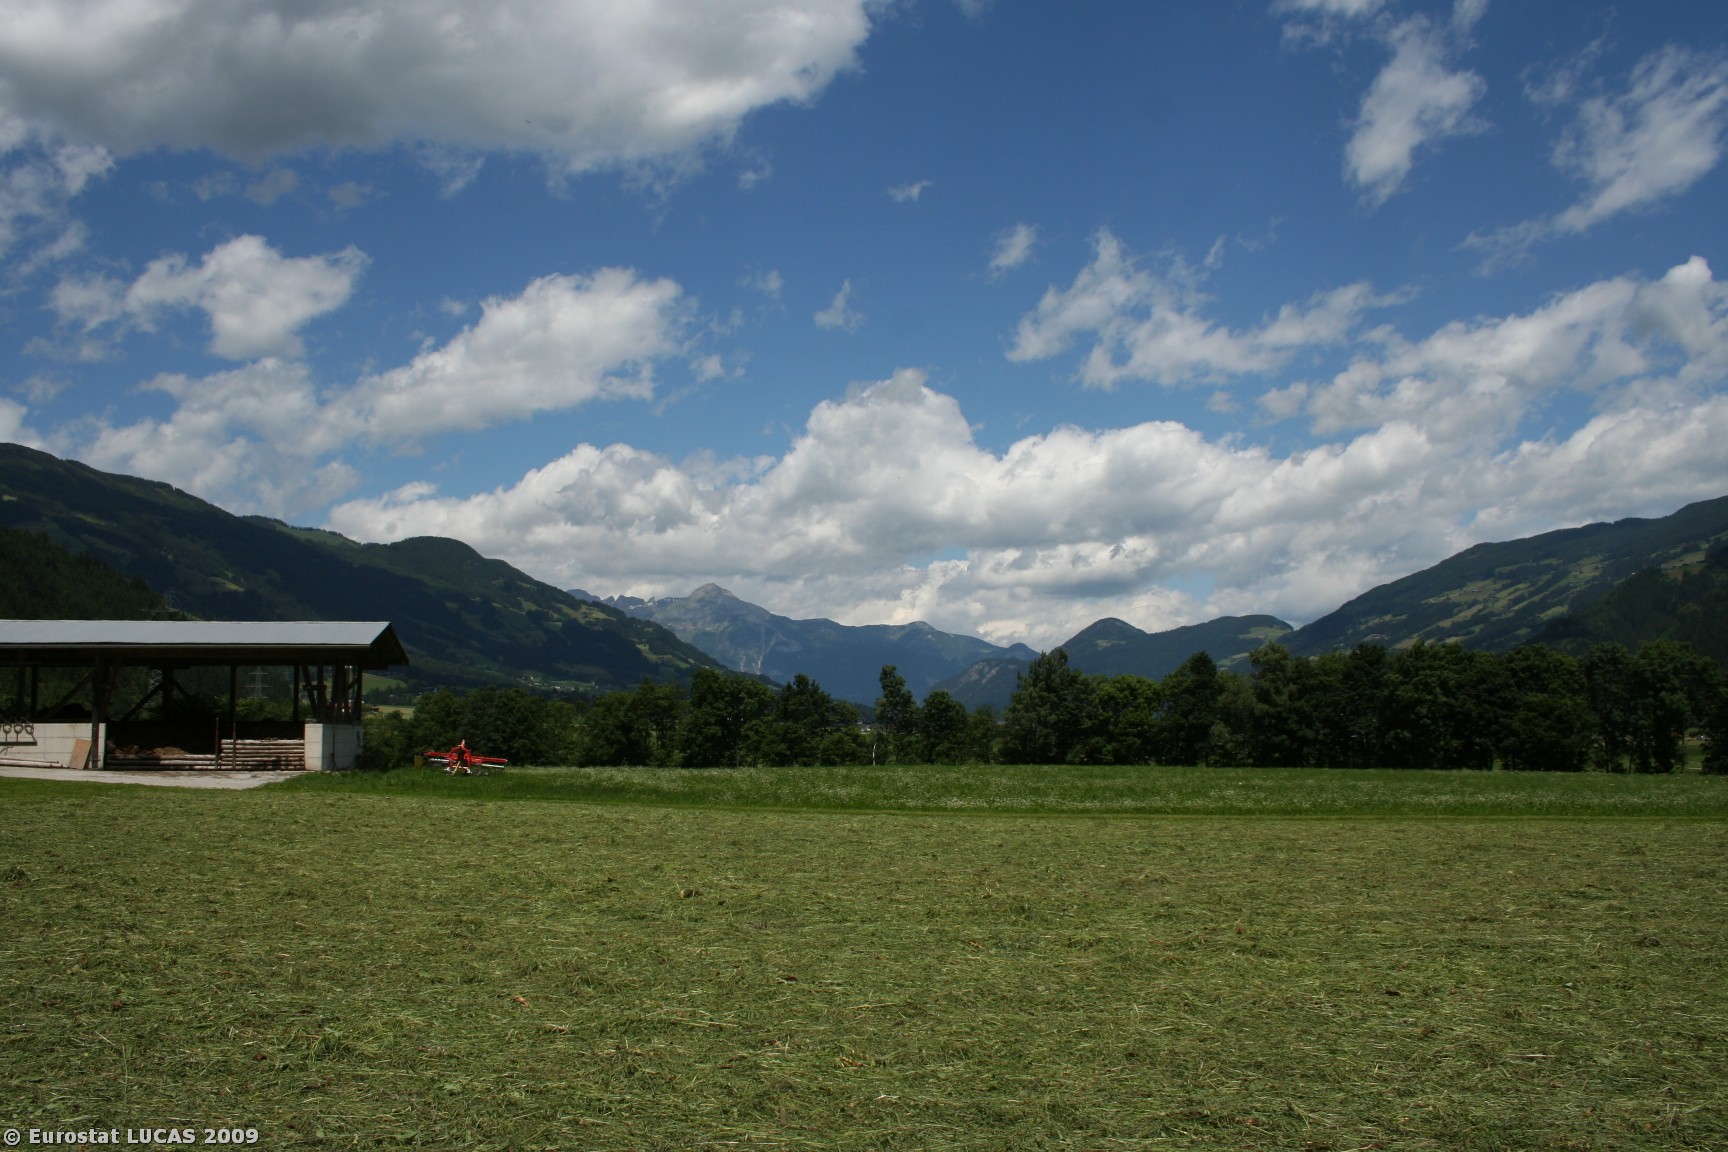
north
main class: Grassland
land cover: Grassland without tree/shrub cover
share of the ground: > 75 %
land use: Agriculture (excluding fallow land and kitchen gardens)
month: June
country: AT
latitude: 47.3076
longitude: 11.8635
